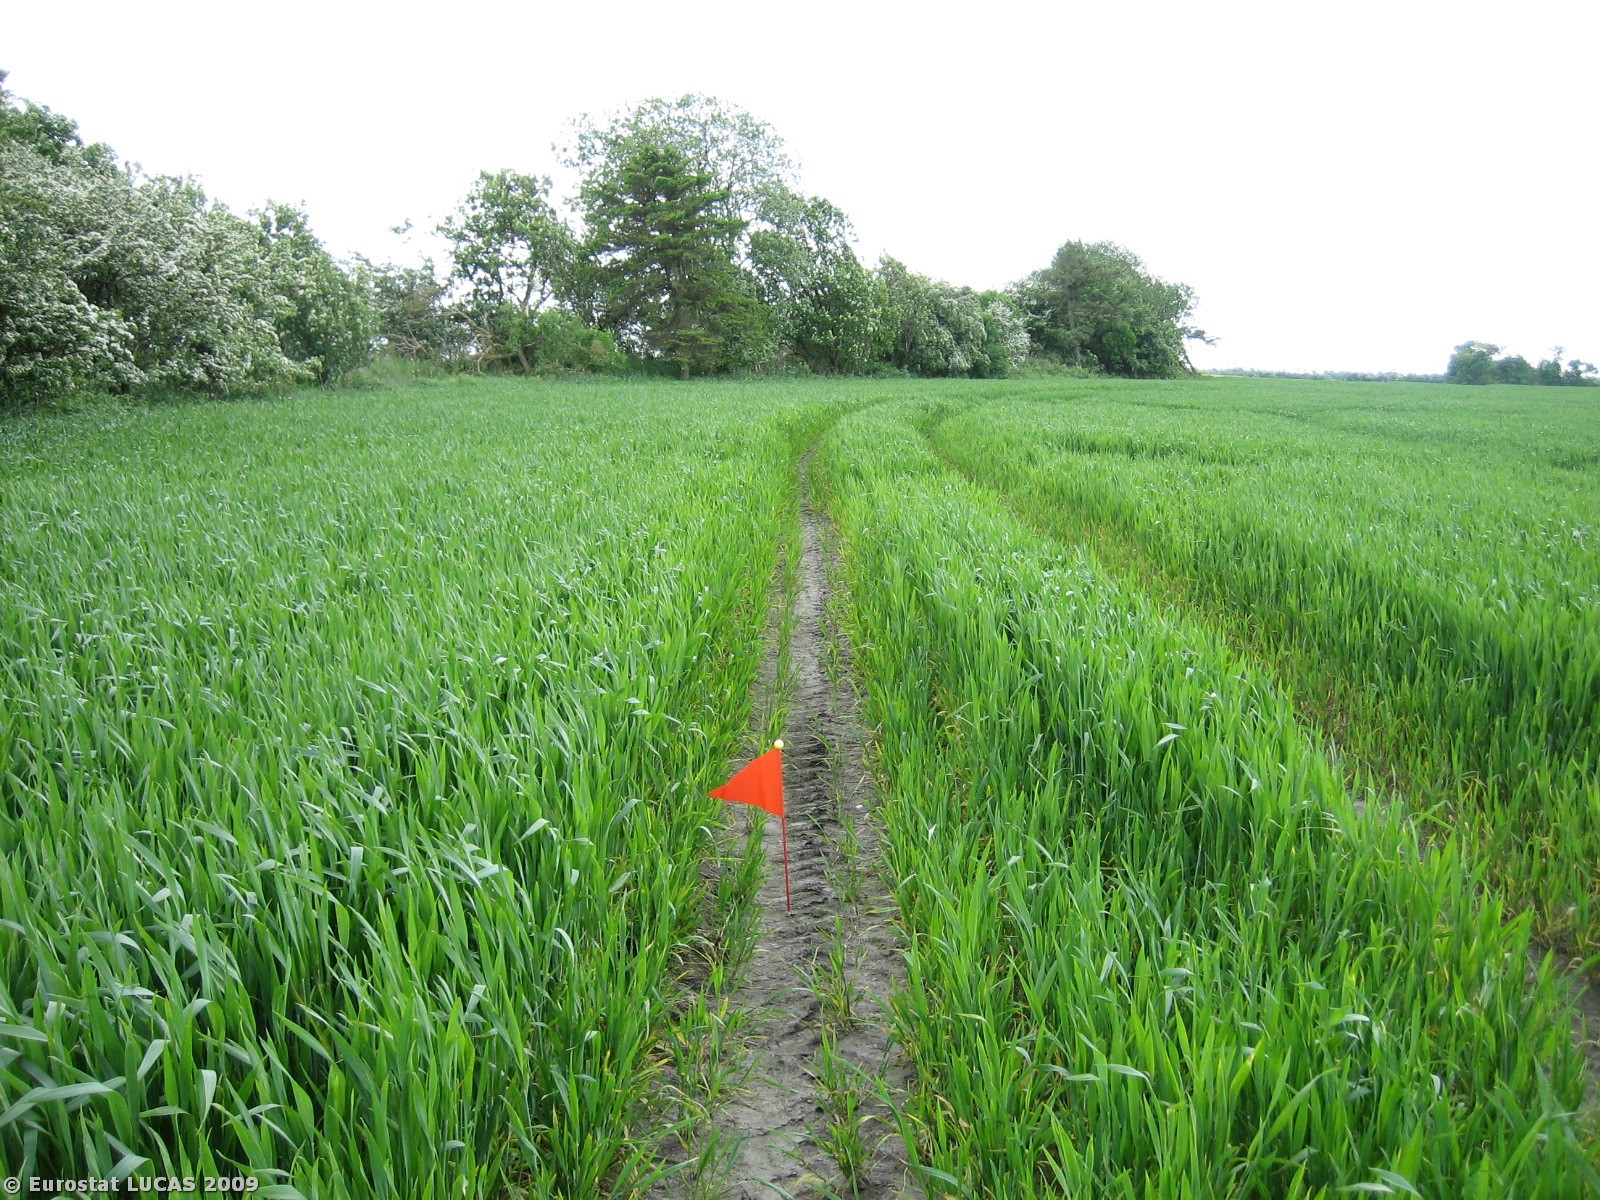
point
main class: Cropland
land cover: Barley
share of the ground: > 75 %
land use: Agriculture (excluding fallow land and kitchen gardens)
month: May
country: DK
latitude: 56.0212
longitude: 8.8942
